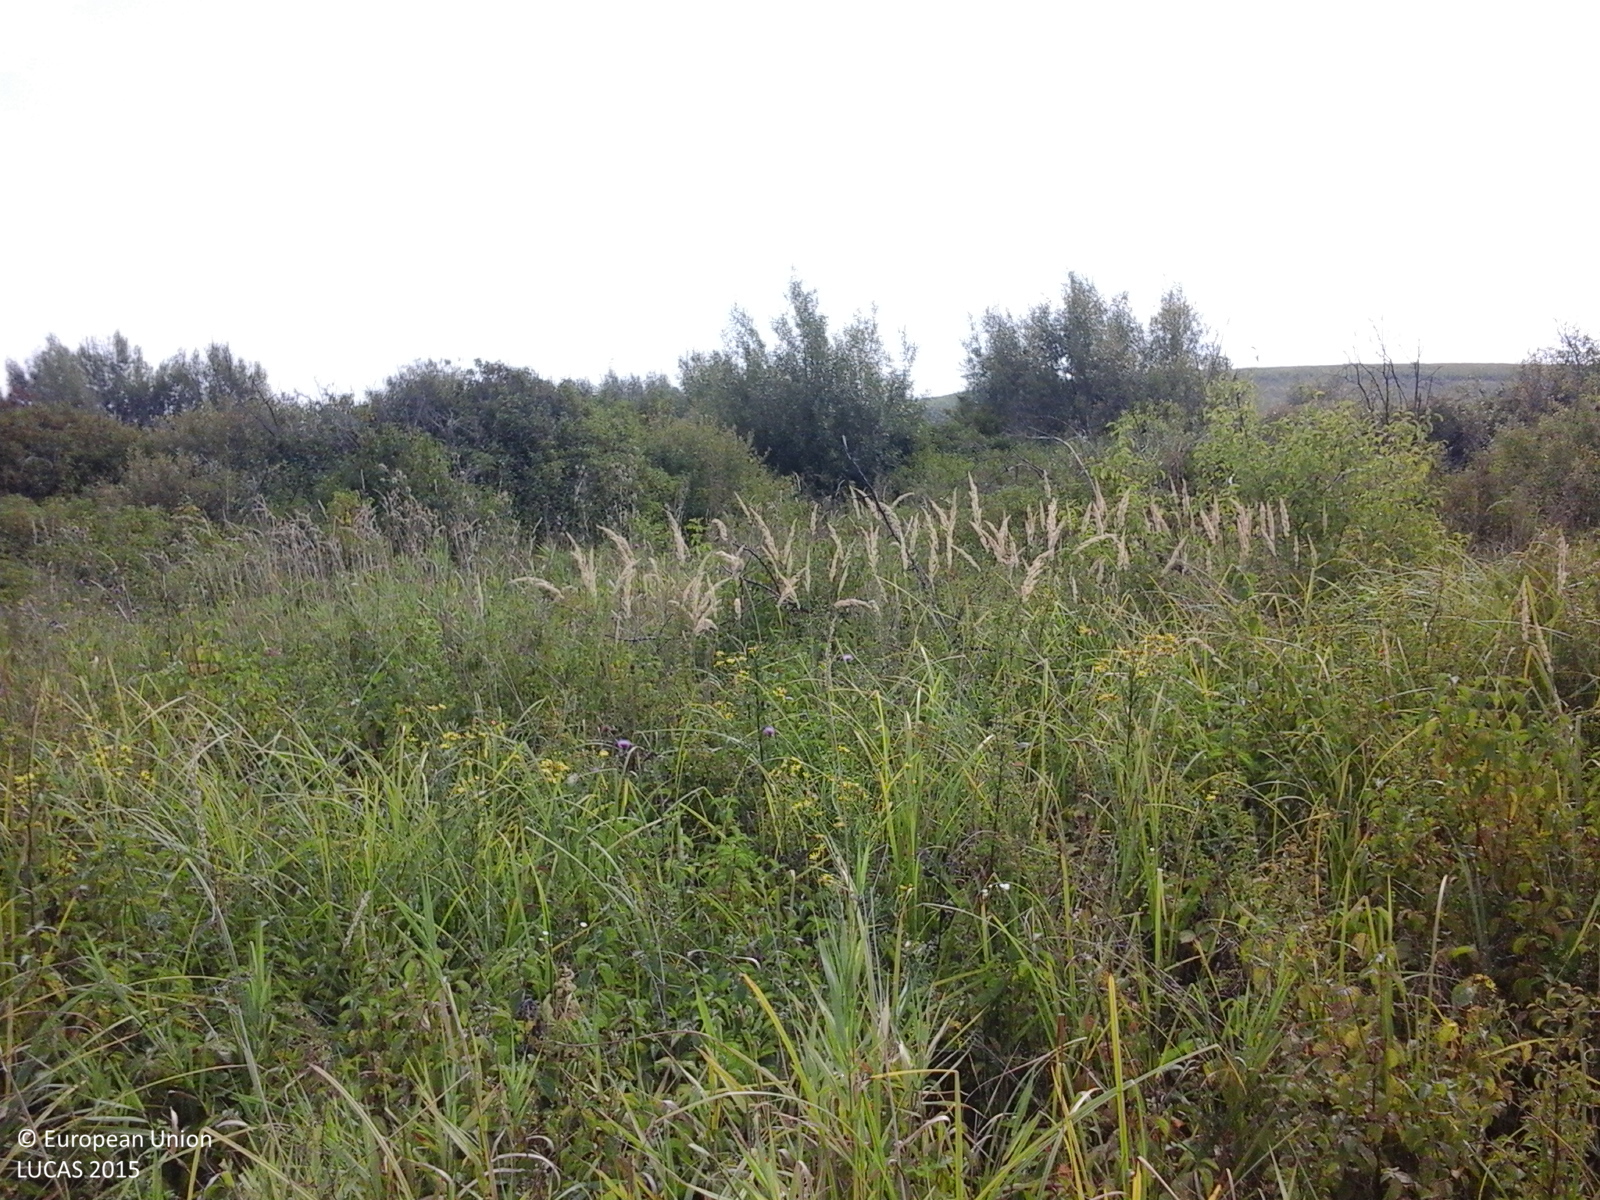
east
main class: Shrubland
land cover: Shrubland with sparse tree cover
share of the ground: > 75 %
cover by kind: herbaceous plants 85 %, shrubs 10 %, broadleaved forest trees 5 %
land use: Semi-natural and natural areas not in use
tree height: < 5 m
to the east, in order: Shrubland with sparse tree cover; Grassland with sparse tree/shrub cover; Shrubland with sparse tree cover; Grass margins; Tracks; Grass margins; Maize
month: August
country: RO
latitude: 46.0710
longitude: 21.5297
